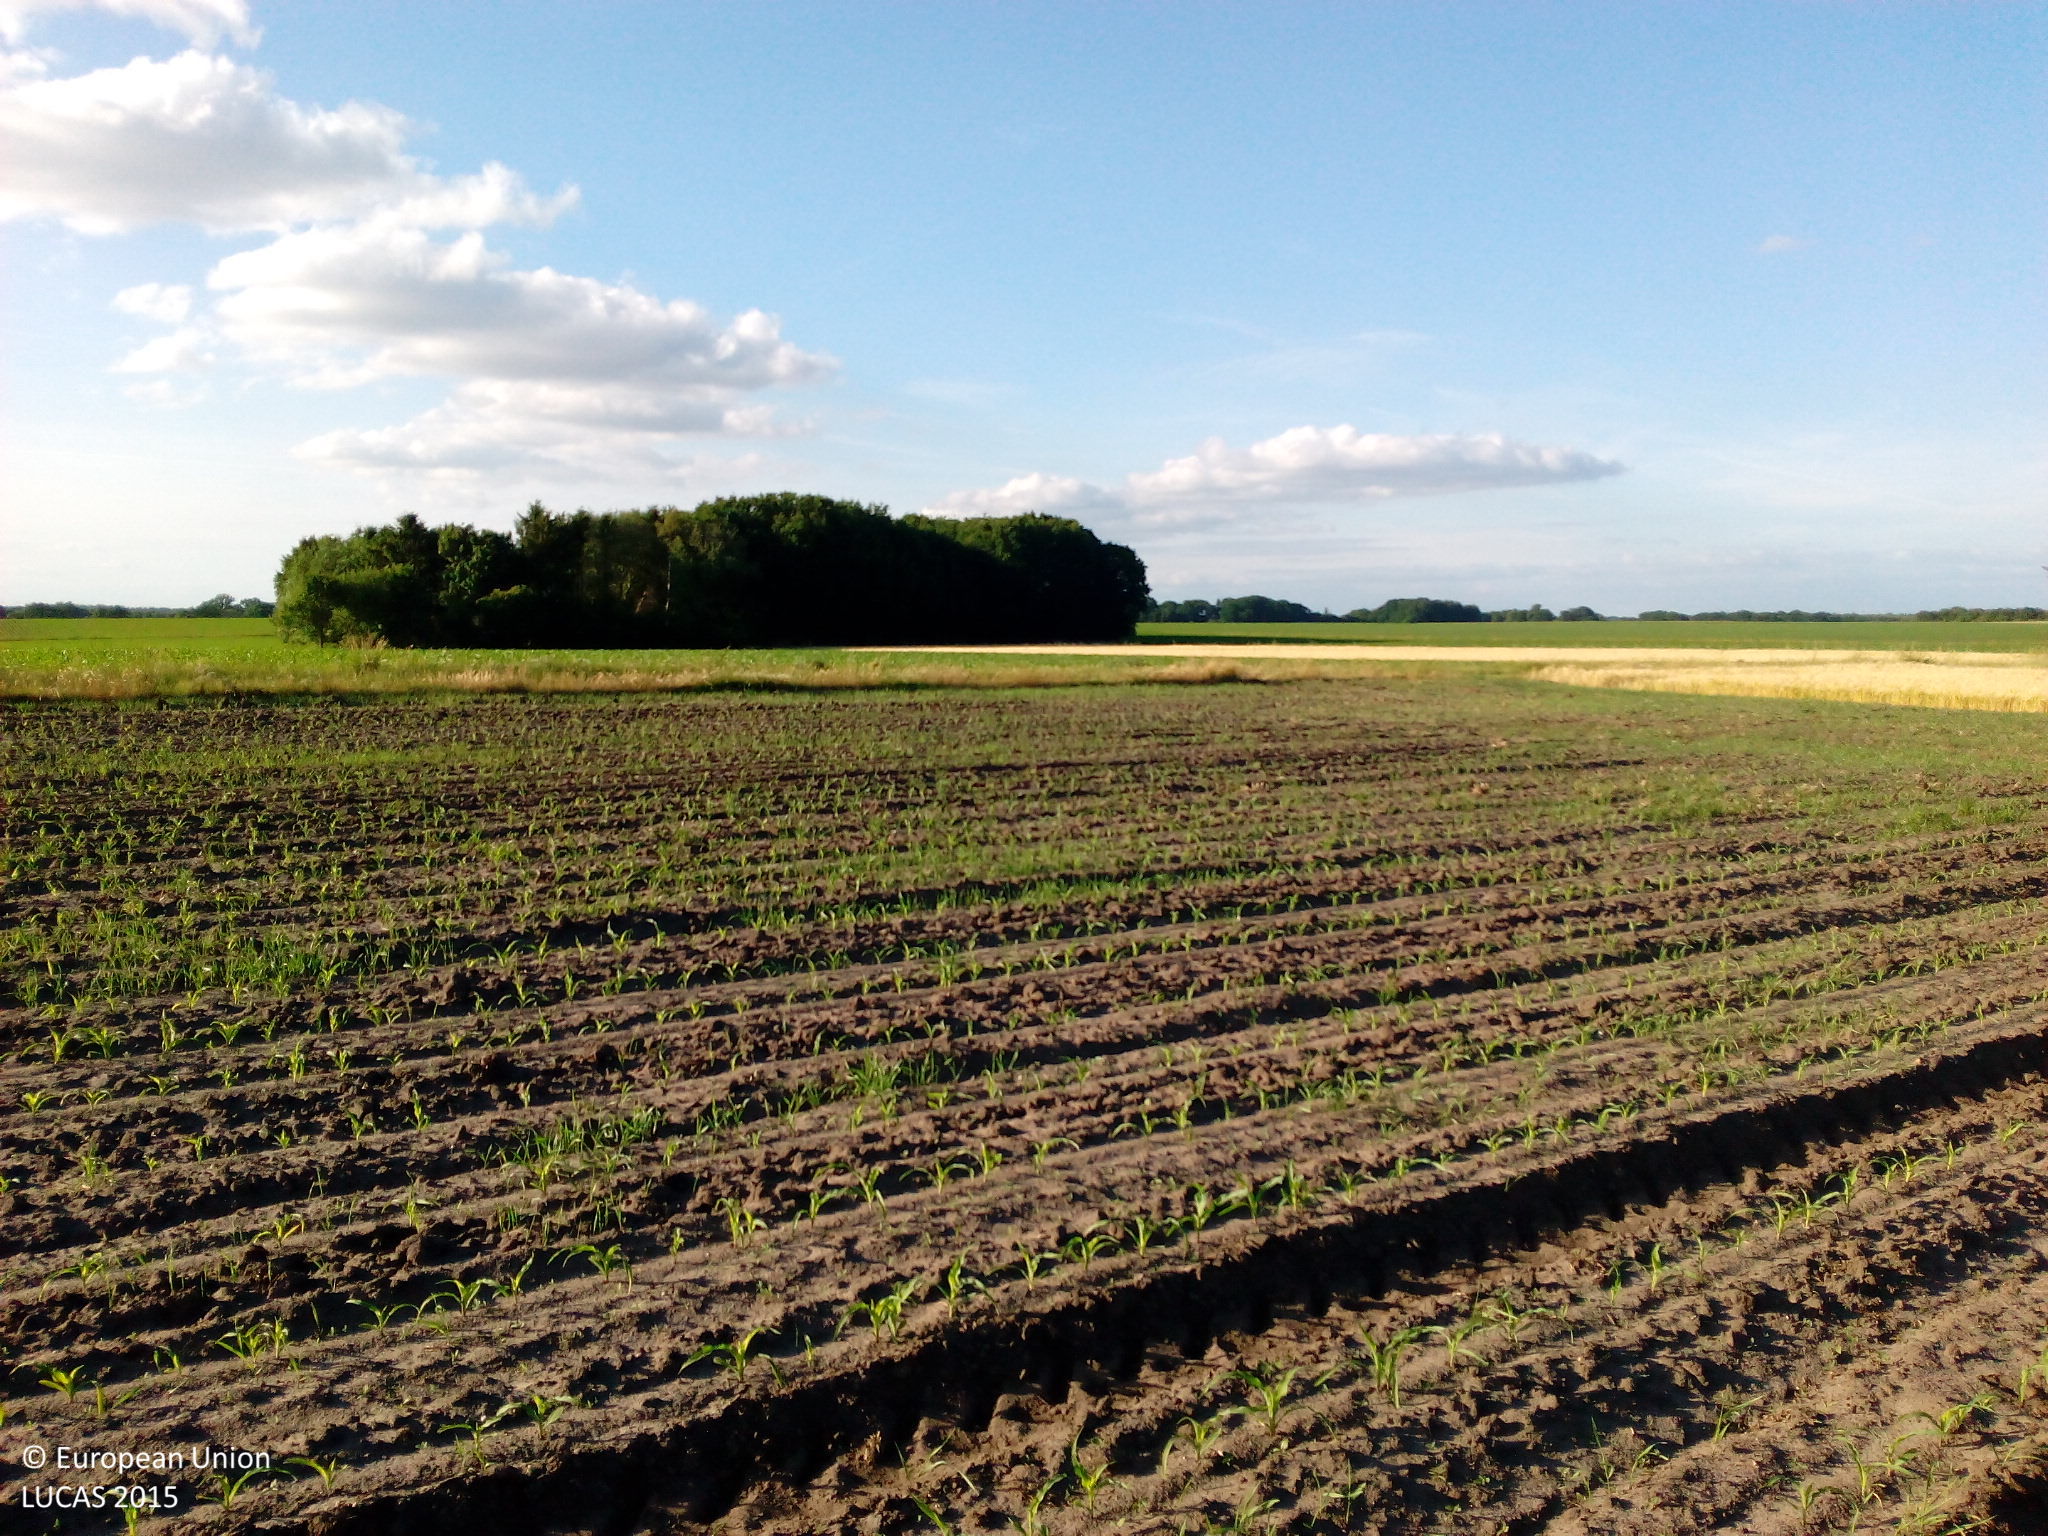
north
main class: Cropland
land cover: Maize
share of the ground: < 10 %
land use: Agriculture (excluding fallow land and kitchen gardens)
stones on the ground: < 10 %
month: June
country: DE
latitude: 52.5114
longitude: 7.4218
